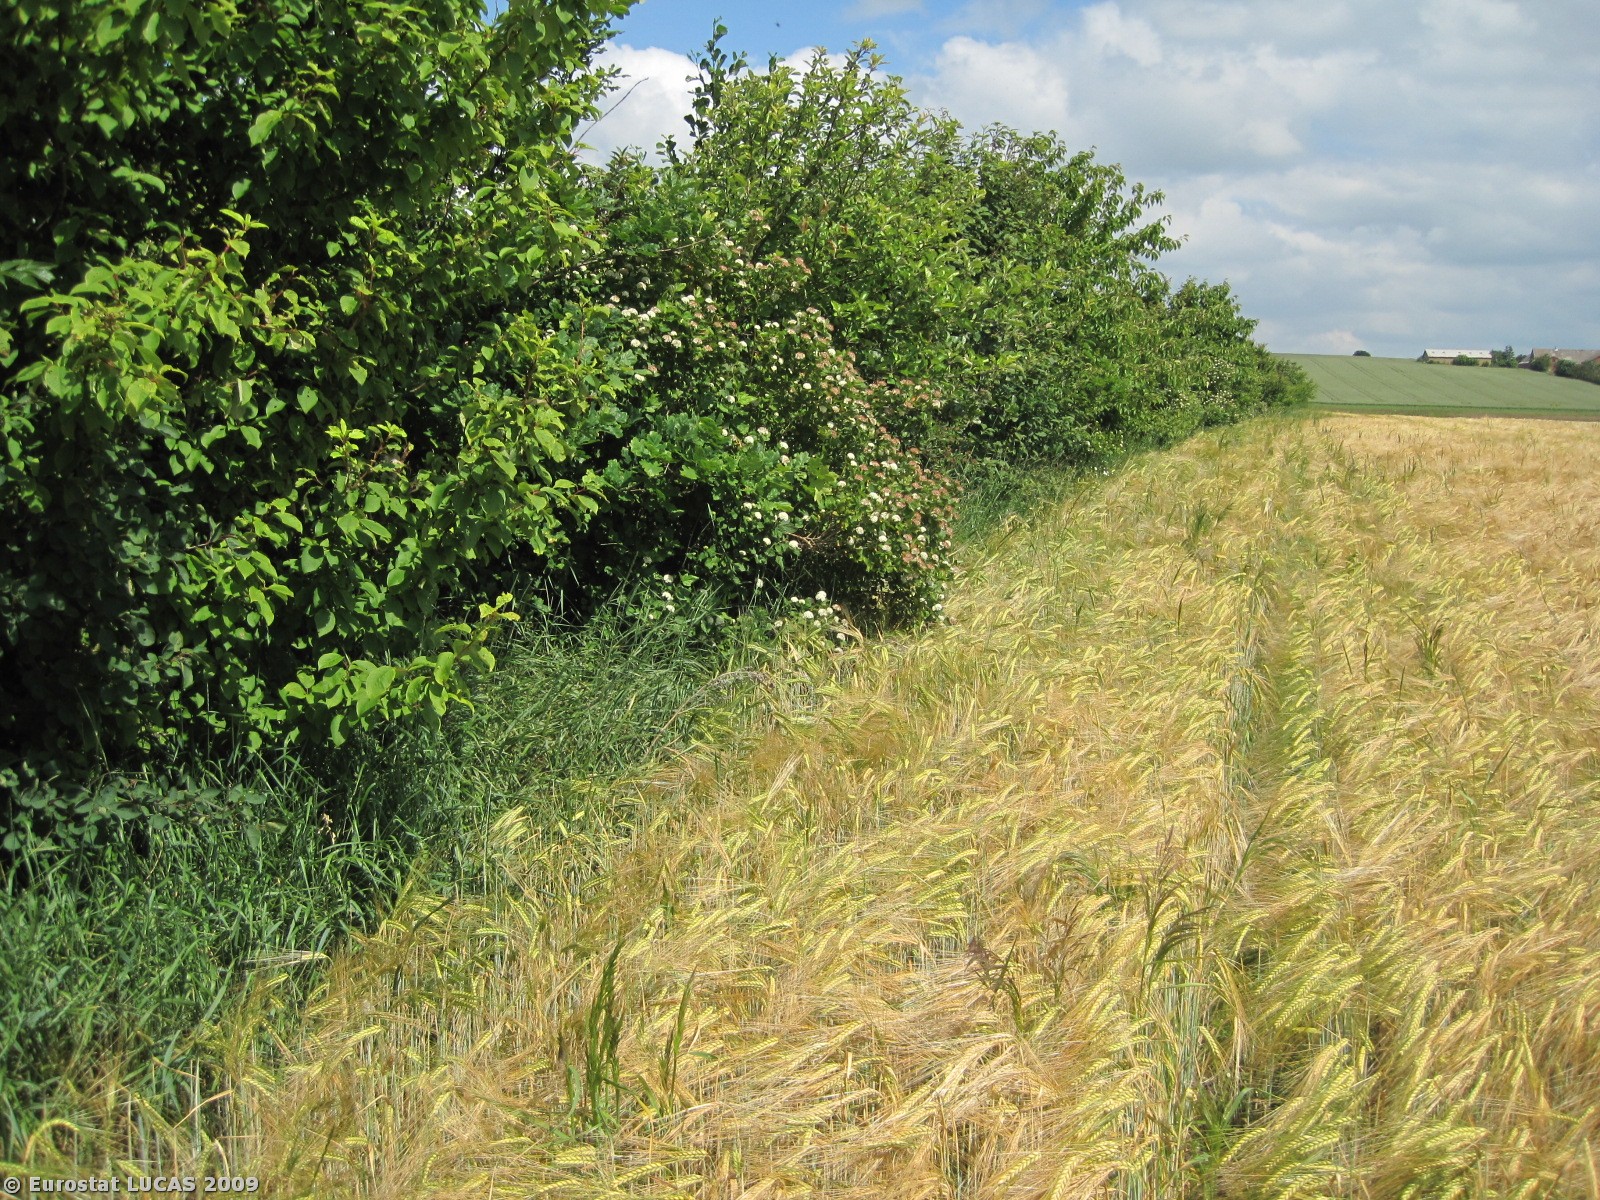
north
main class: Cropland
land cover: Barley
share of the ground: > 75 %
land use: Agriculture (excluding fallow land and kitchen gardens)
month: June
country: DK
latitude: 56.5609
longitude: 8.9437
